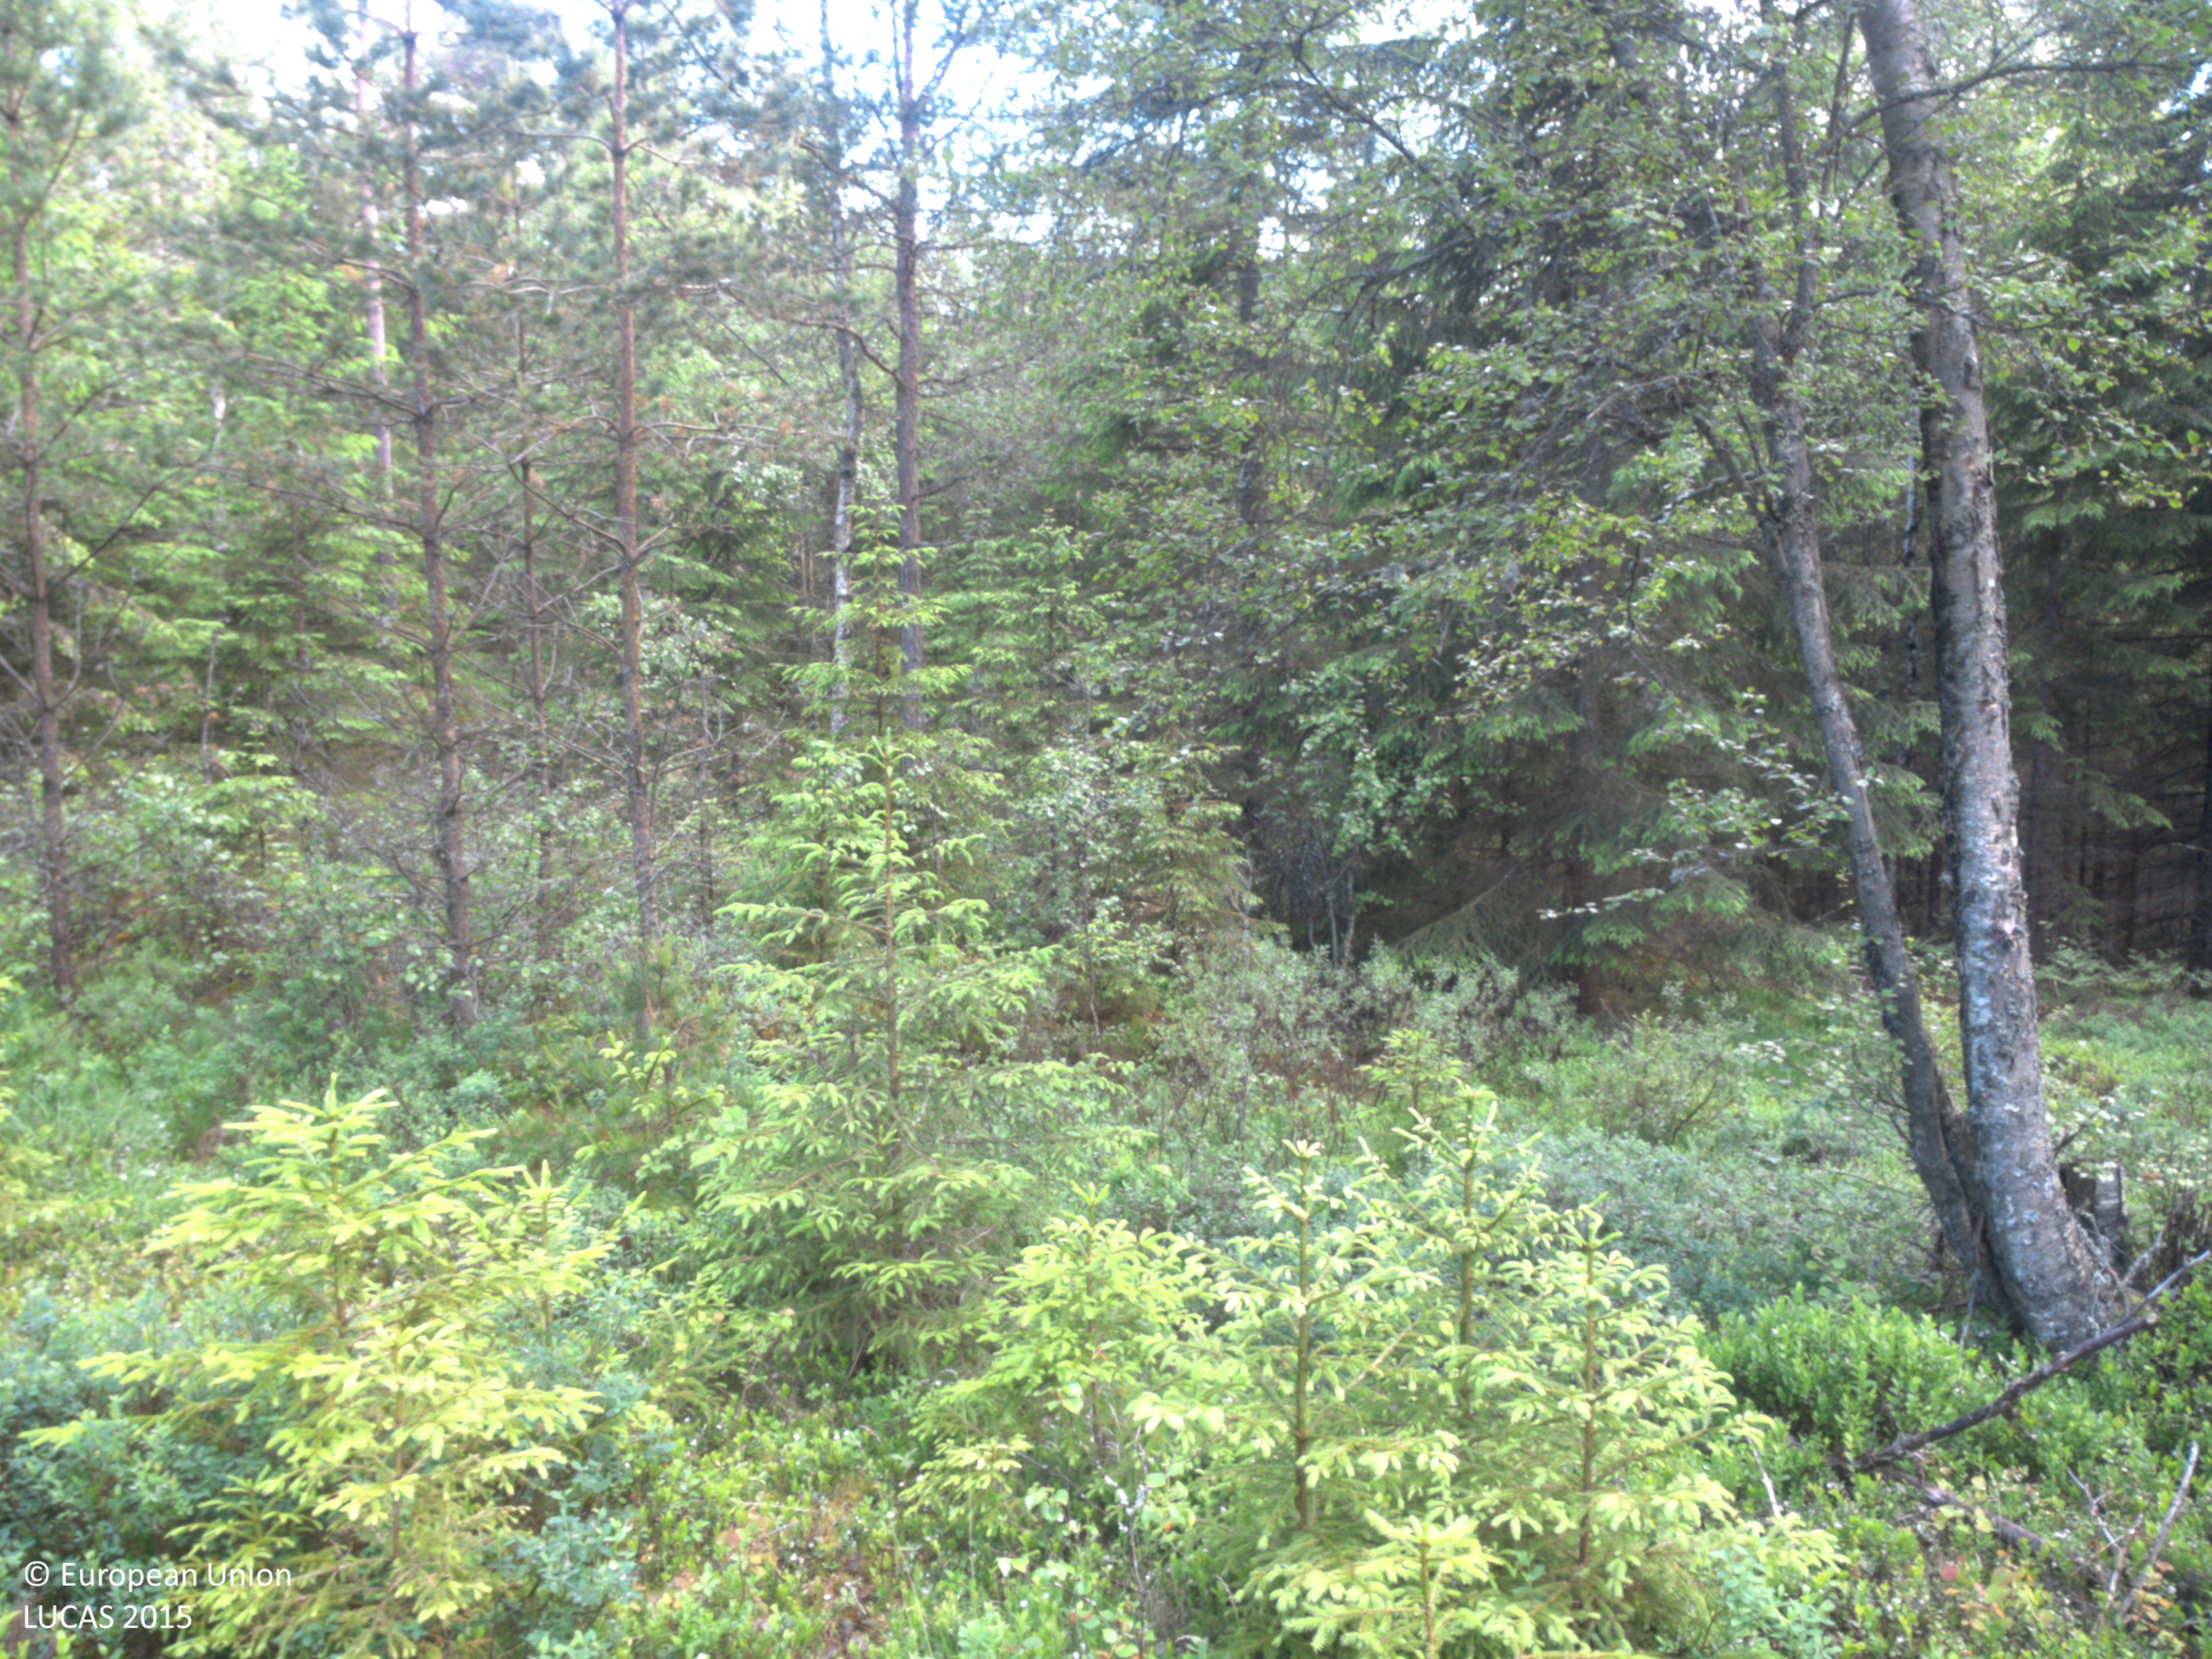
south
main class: Woodland
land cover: Other mixed woodland
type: boreal forest
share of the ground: 50 - 75 %
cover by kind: coniferous forest trees 50 %, herbaceous plants 30 %, broadleaved forest trees 20 %
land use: Forestry
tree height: > 5 m
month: June
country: SE
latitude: 58.8575
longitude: 11.6085
